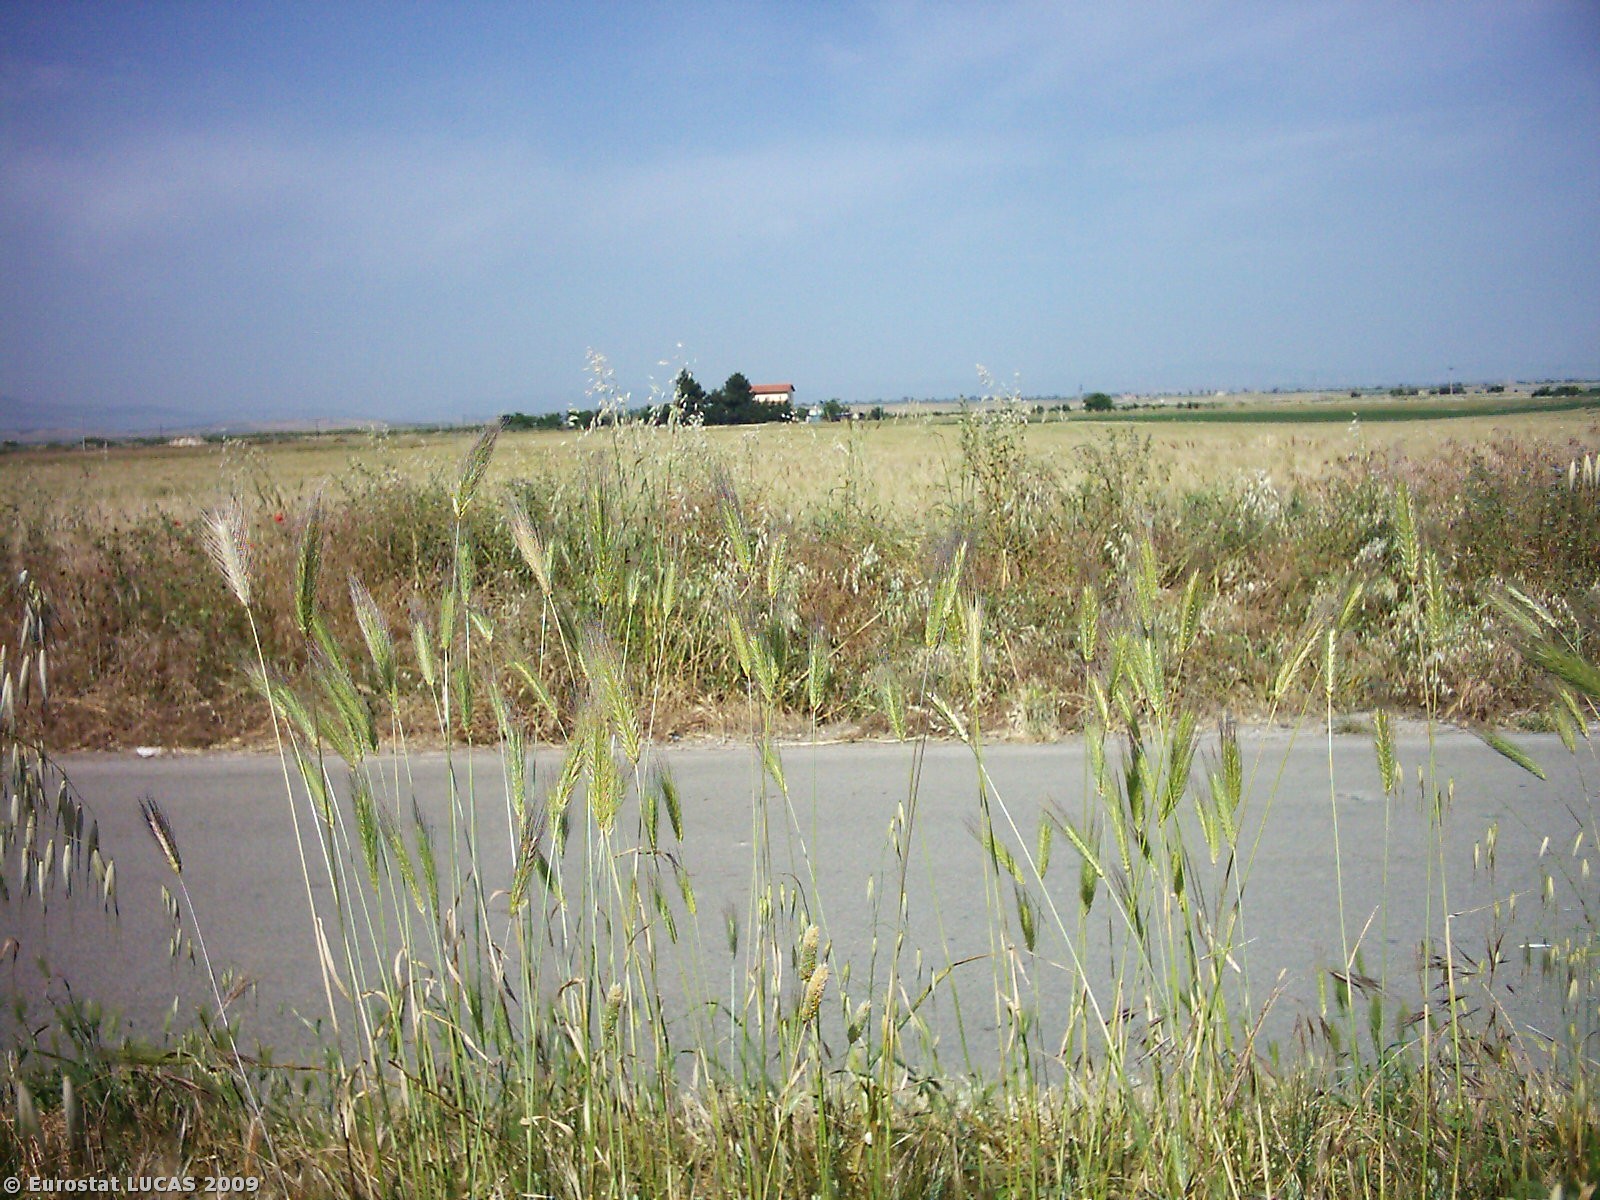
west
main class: Cropland
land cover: Durum wheat
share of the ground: > 75 %
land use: Agriculture (excluding fallow land and kitchen gardens)
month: May
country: IT
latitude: 41.3202
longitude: 15.6319
